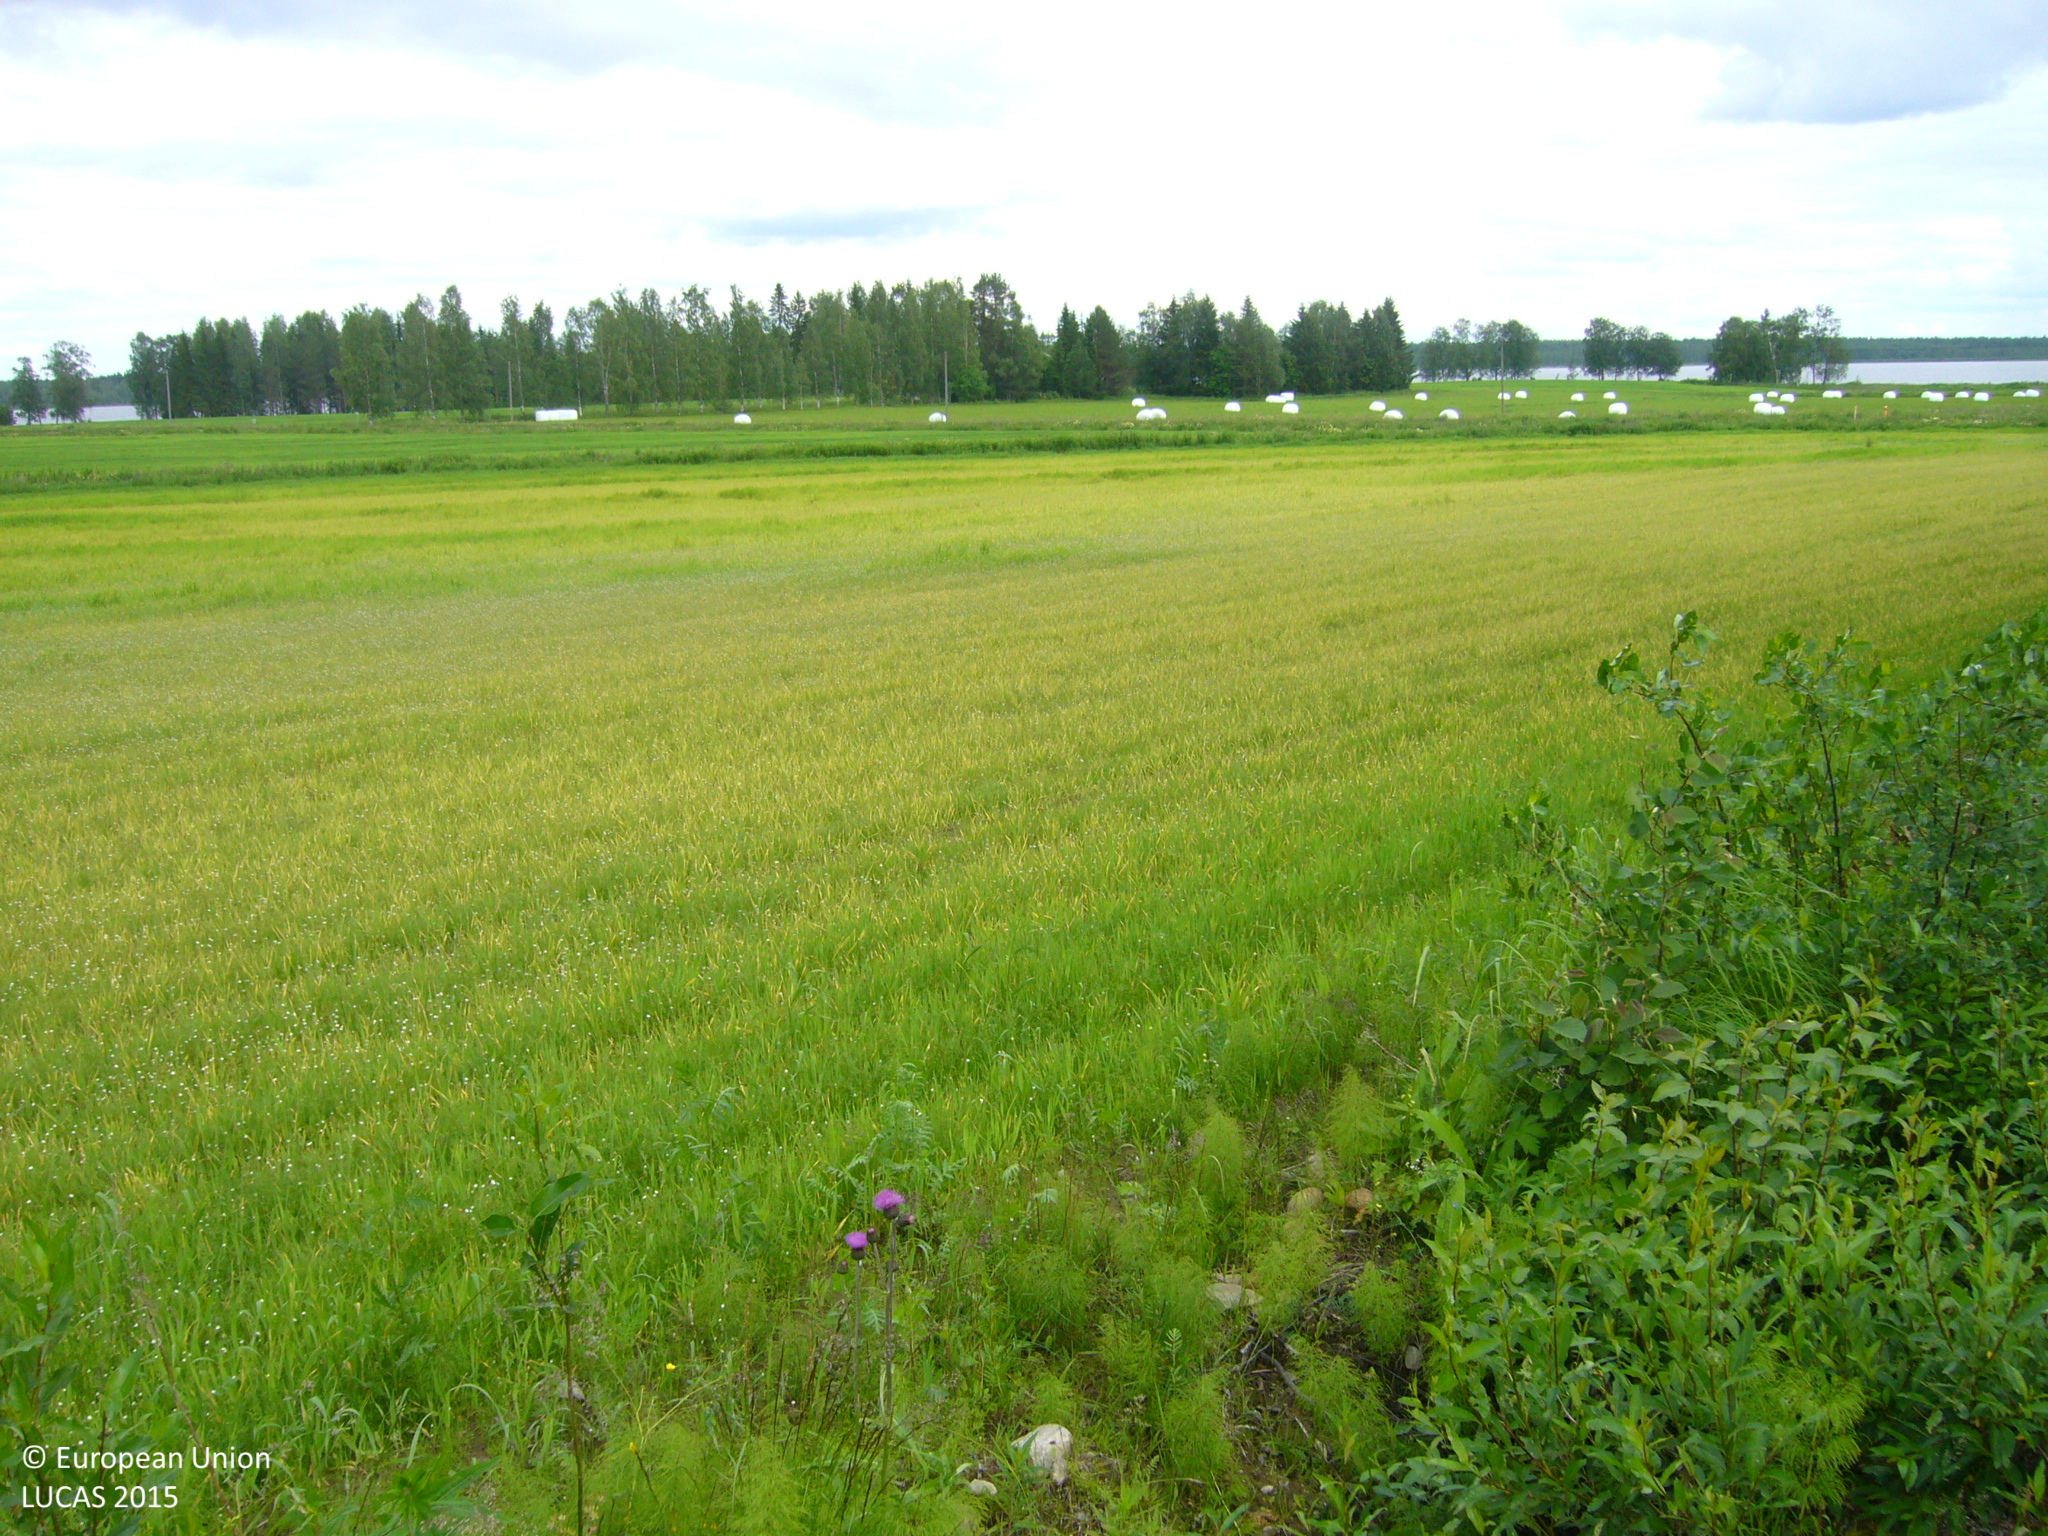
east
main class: Cropland
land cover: Barley
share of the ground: > 75 %
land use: Agriculture (excluding fallow land and kitchen gardens)
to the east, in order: Barley; Grass margins; Abandoned hedges; Shruby margins; Ditches and canals; Grass margins; Barley
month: July
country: FI
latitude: 63.7124
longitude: 25.9565
